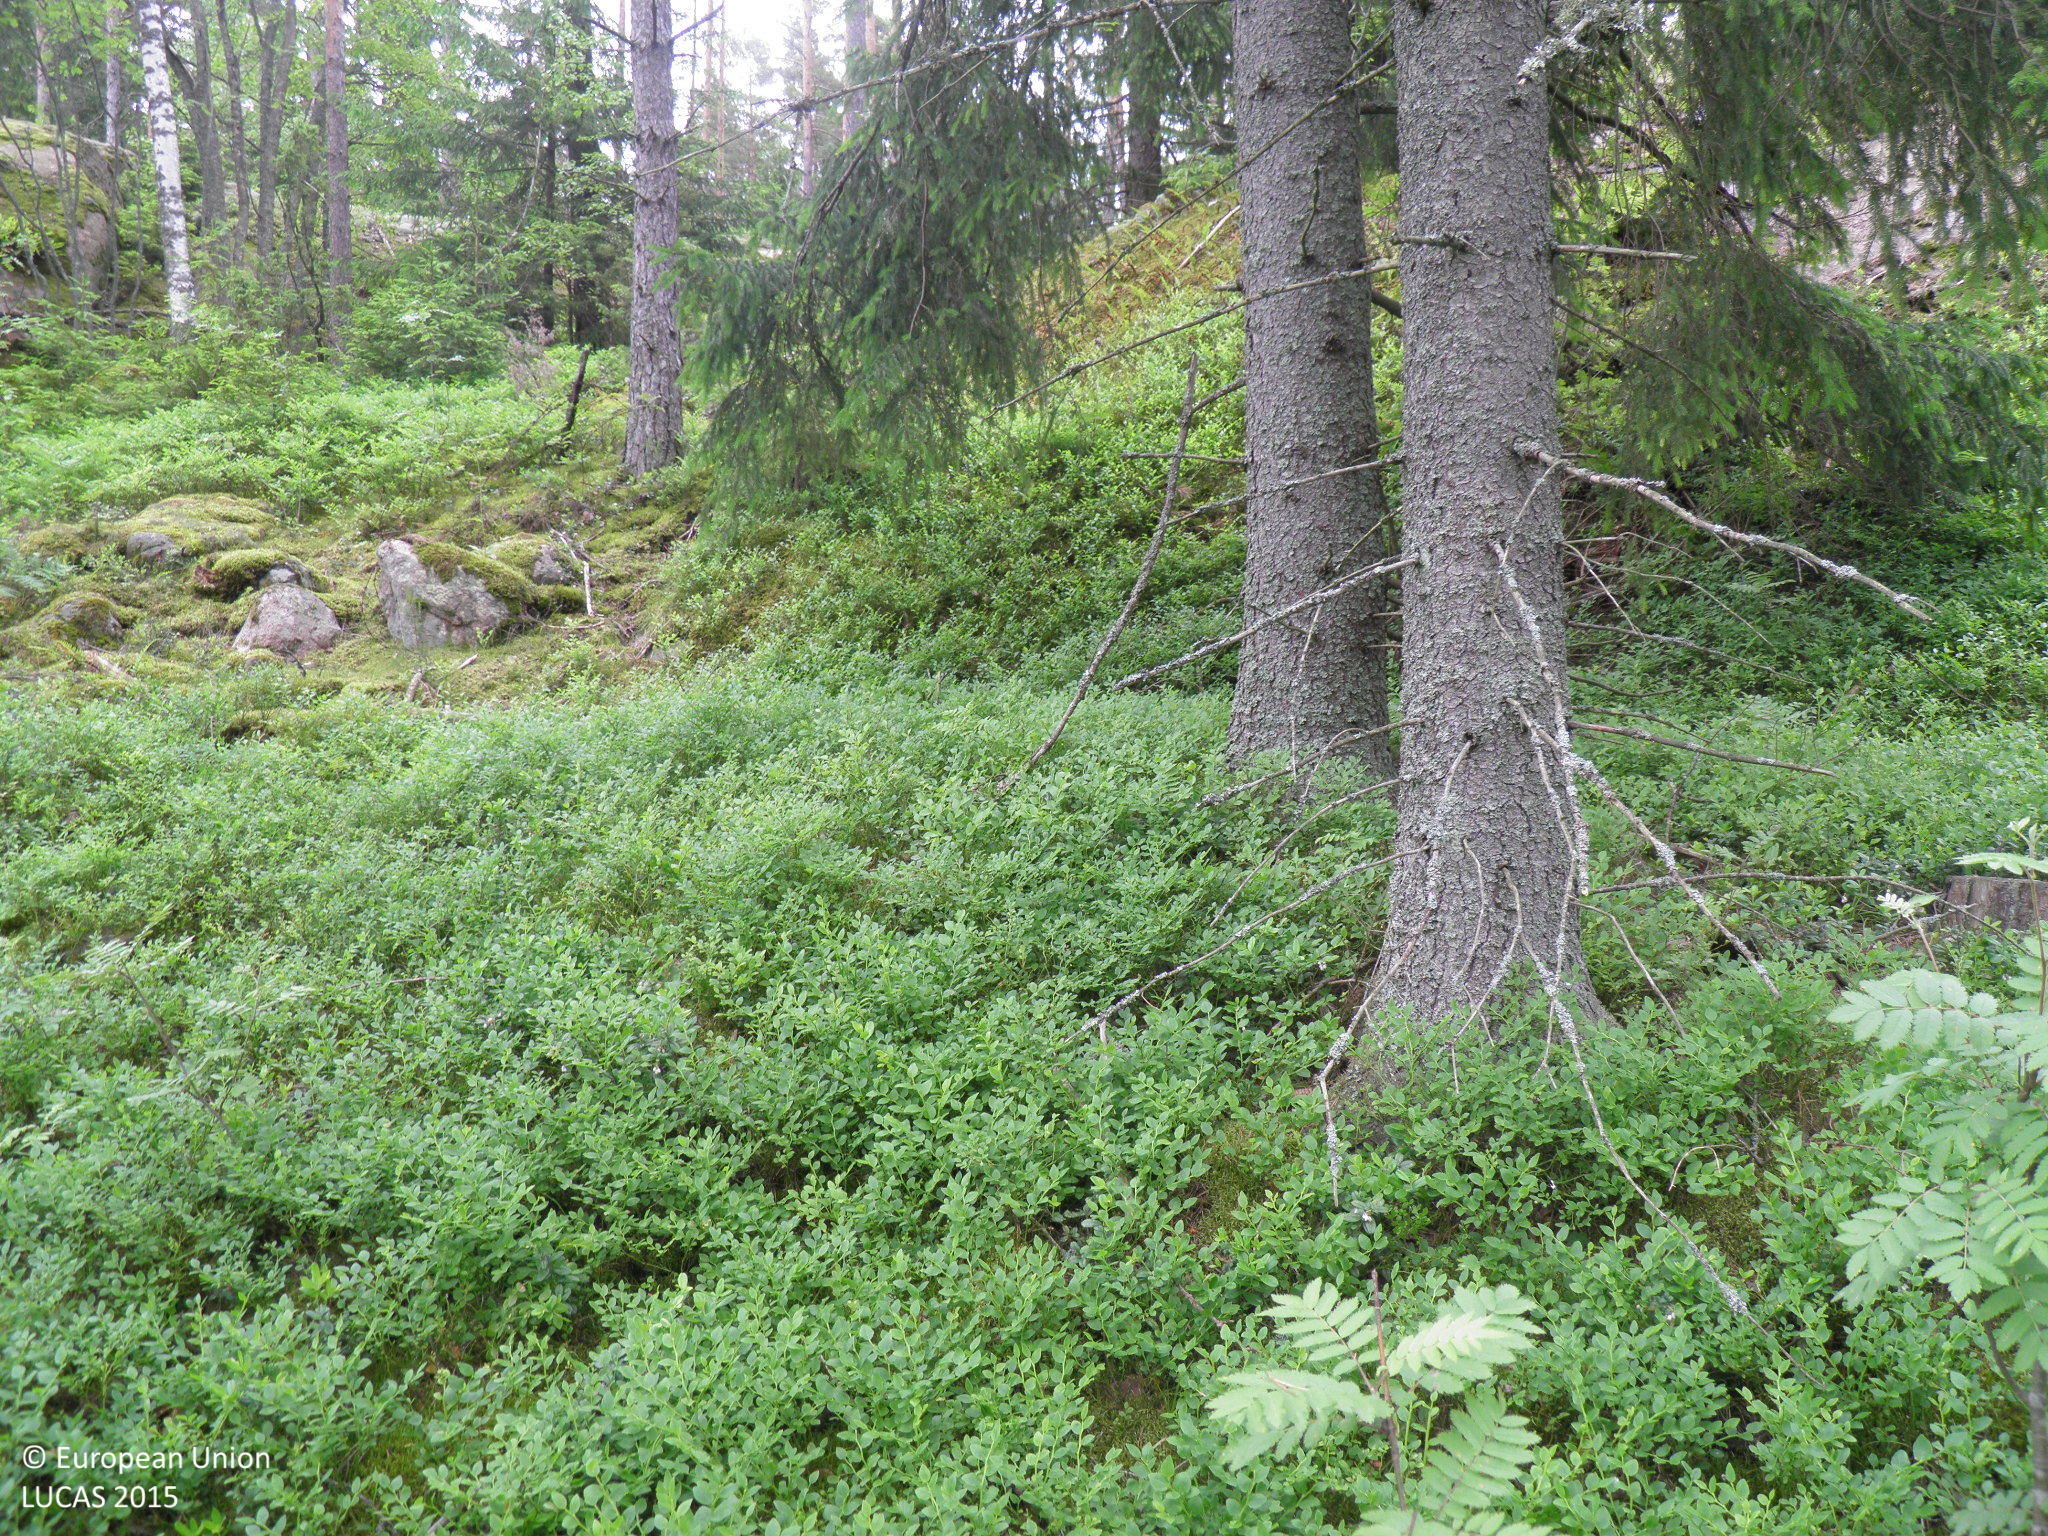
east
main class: Woodland
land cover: Other coniferous woodland
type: hemiboreal forest and nemoral coniferous forest and mixed broadleaved-coniferous forest
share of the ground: > 75 %
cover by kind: coniferous forest trees 70 %, broadleaved forest trees 10 %, shrubs 10 %, herbaceous plants 10 %
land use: Forestry
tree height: > 5 m
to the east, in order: Other coniferous woodland
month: June
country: FI
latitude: 60.3079
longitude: 22.1746
